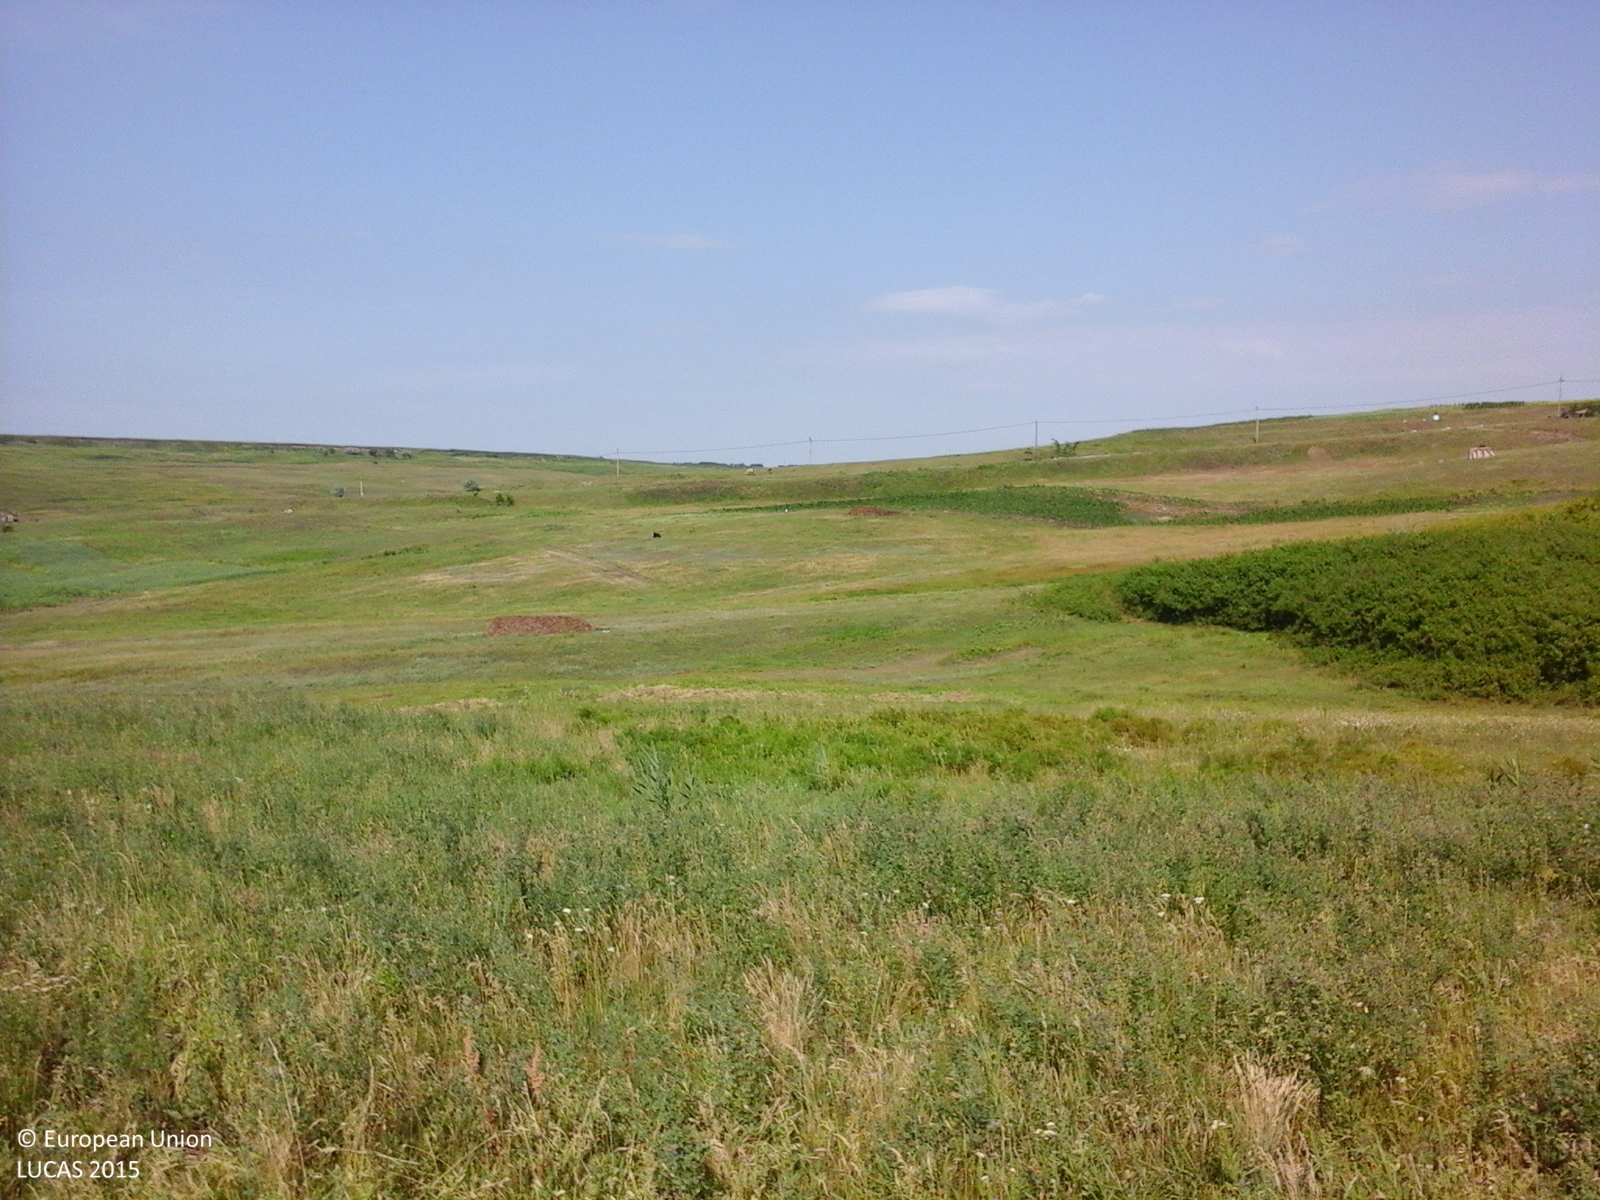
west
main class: Grassland
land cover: Grassland without tree/shrub cover
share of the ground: > 75 %
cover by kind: herbaceous plants 100 %
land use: Agriculture (excluding fallow land and kitchen gardens)
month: June
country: RO
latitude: 47.9542
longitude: 26.6607
